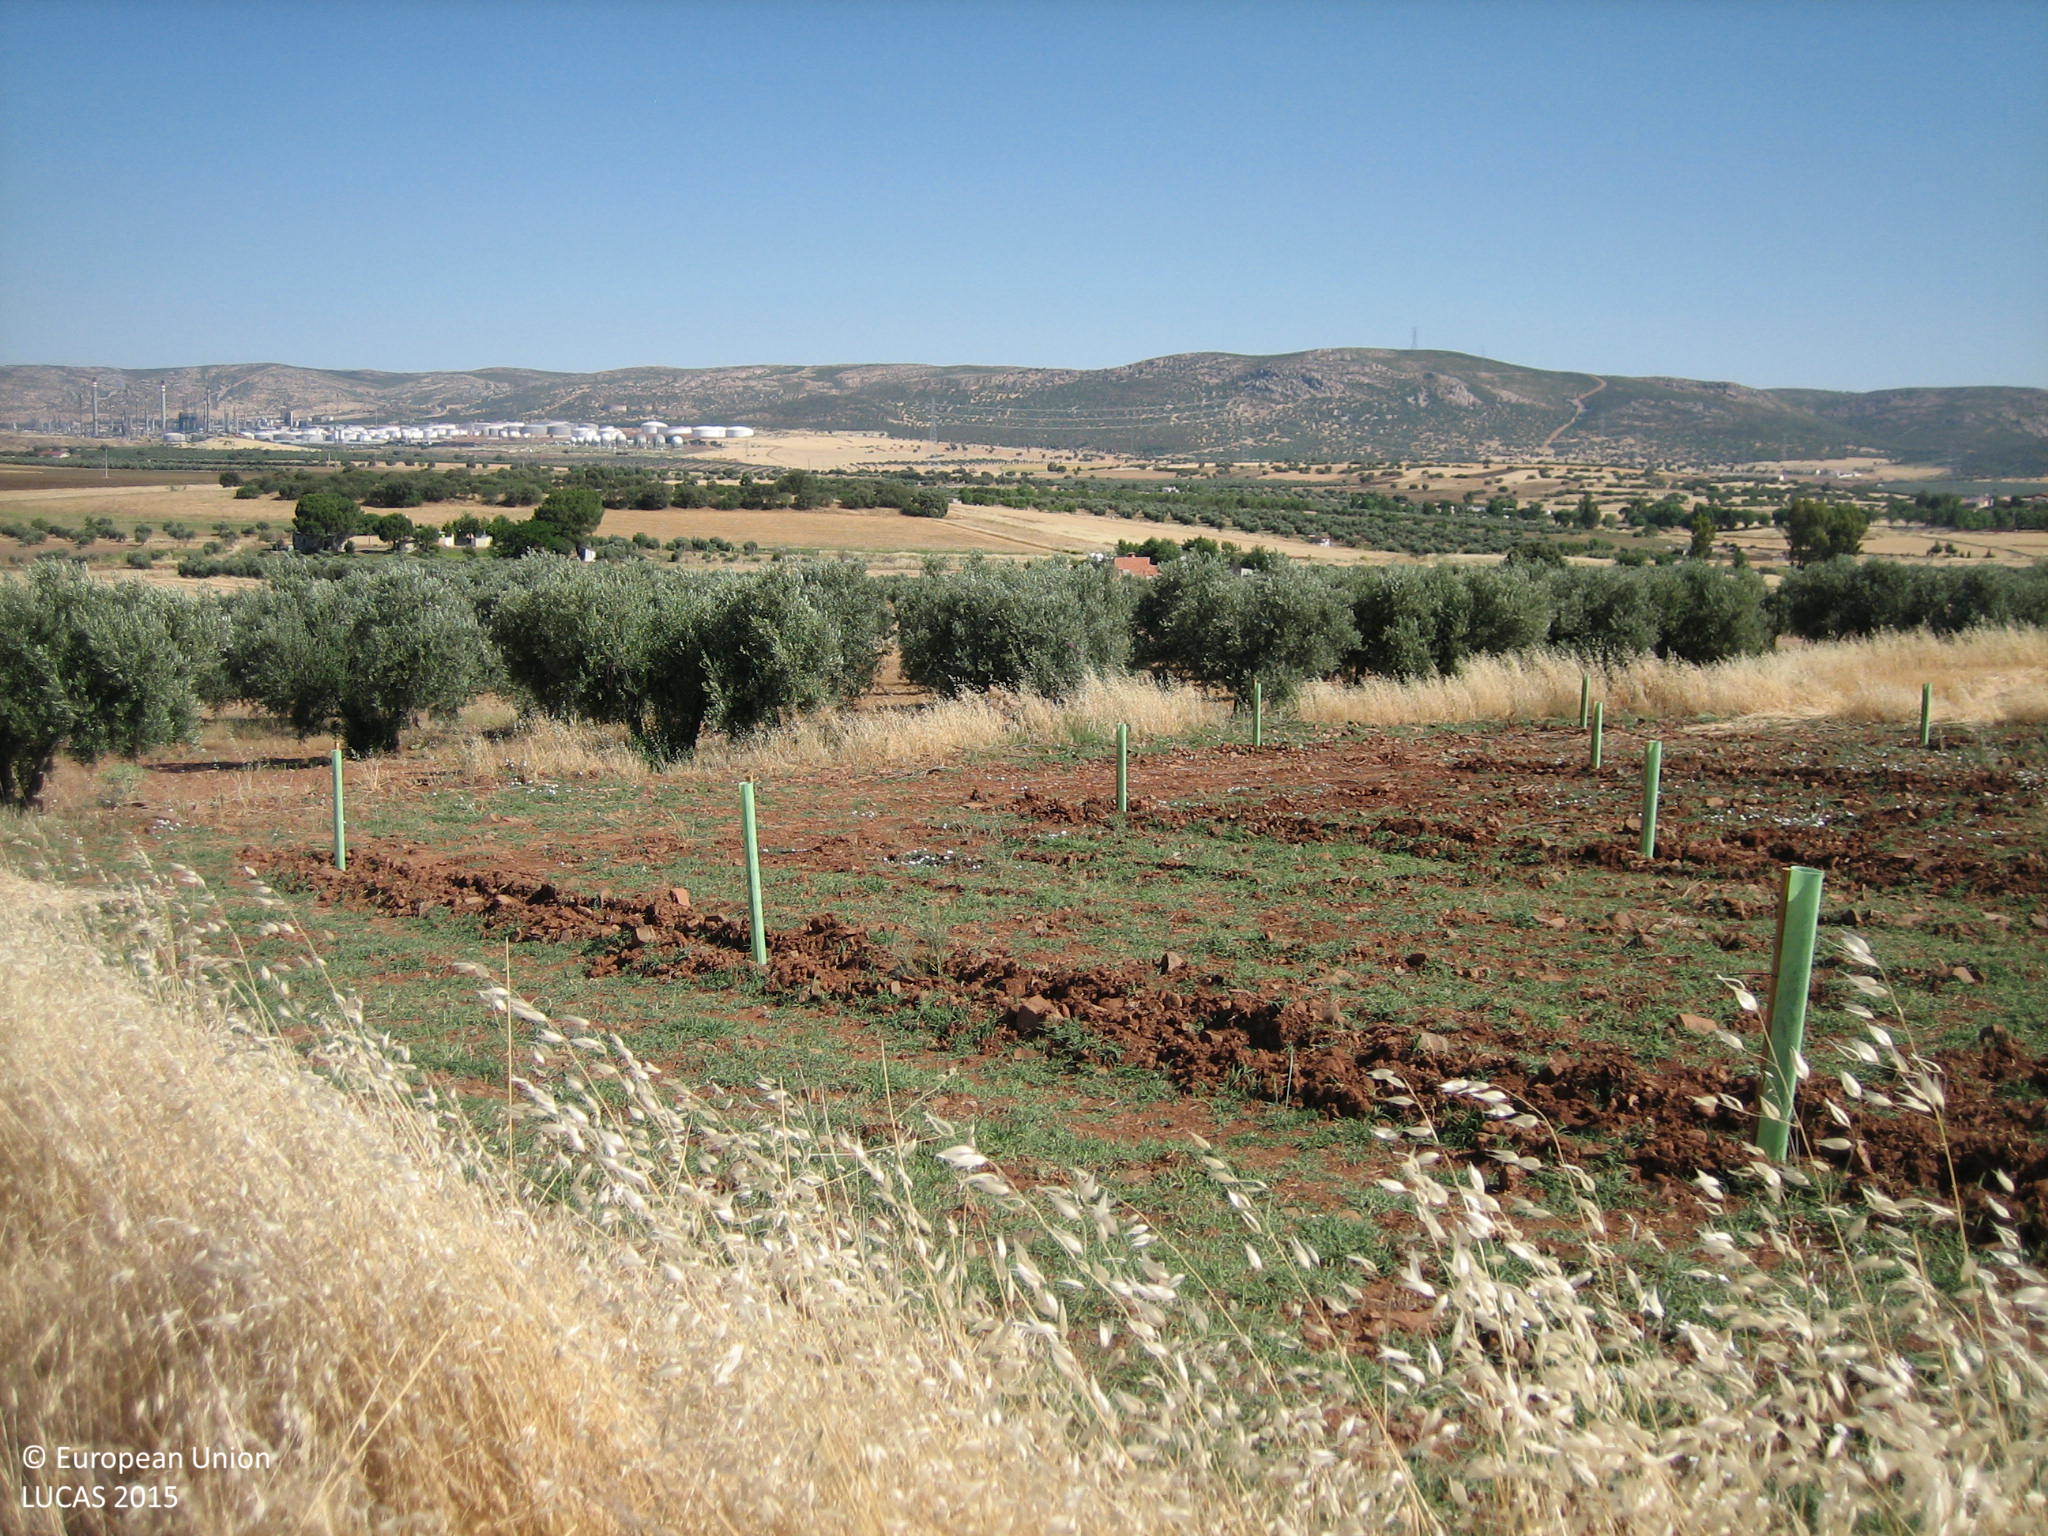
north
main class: Cropland
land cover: Common wheat
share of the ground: < 10 %
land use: Agriculture (excluding fallow land and kitchen gardens)
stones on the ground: < 10 %
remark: Harvested field
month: June
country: ES
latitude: 38.6315
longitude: -4.0194
